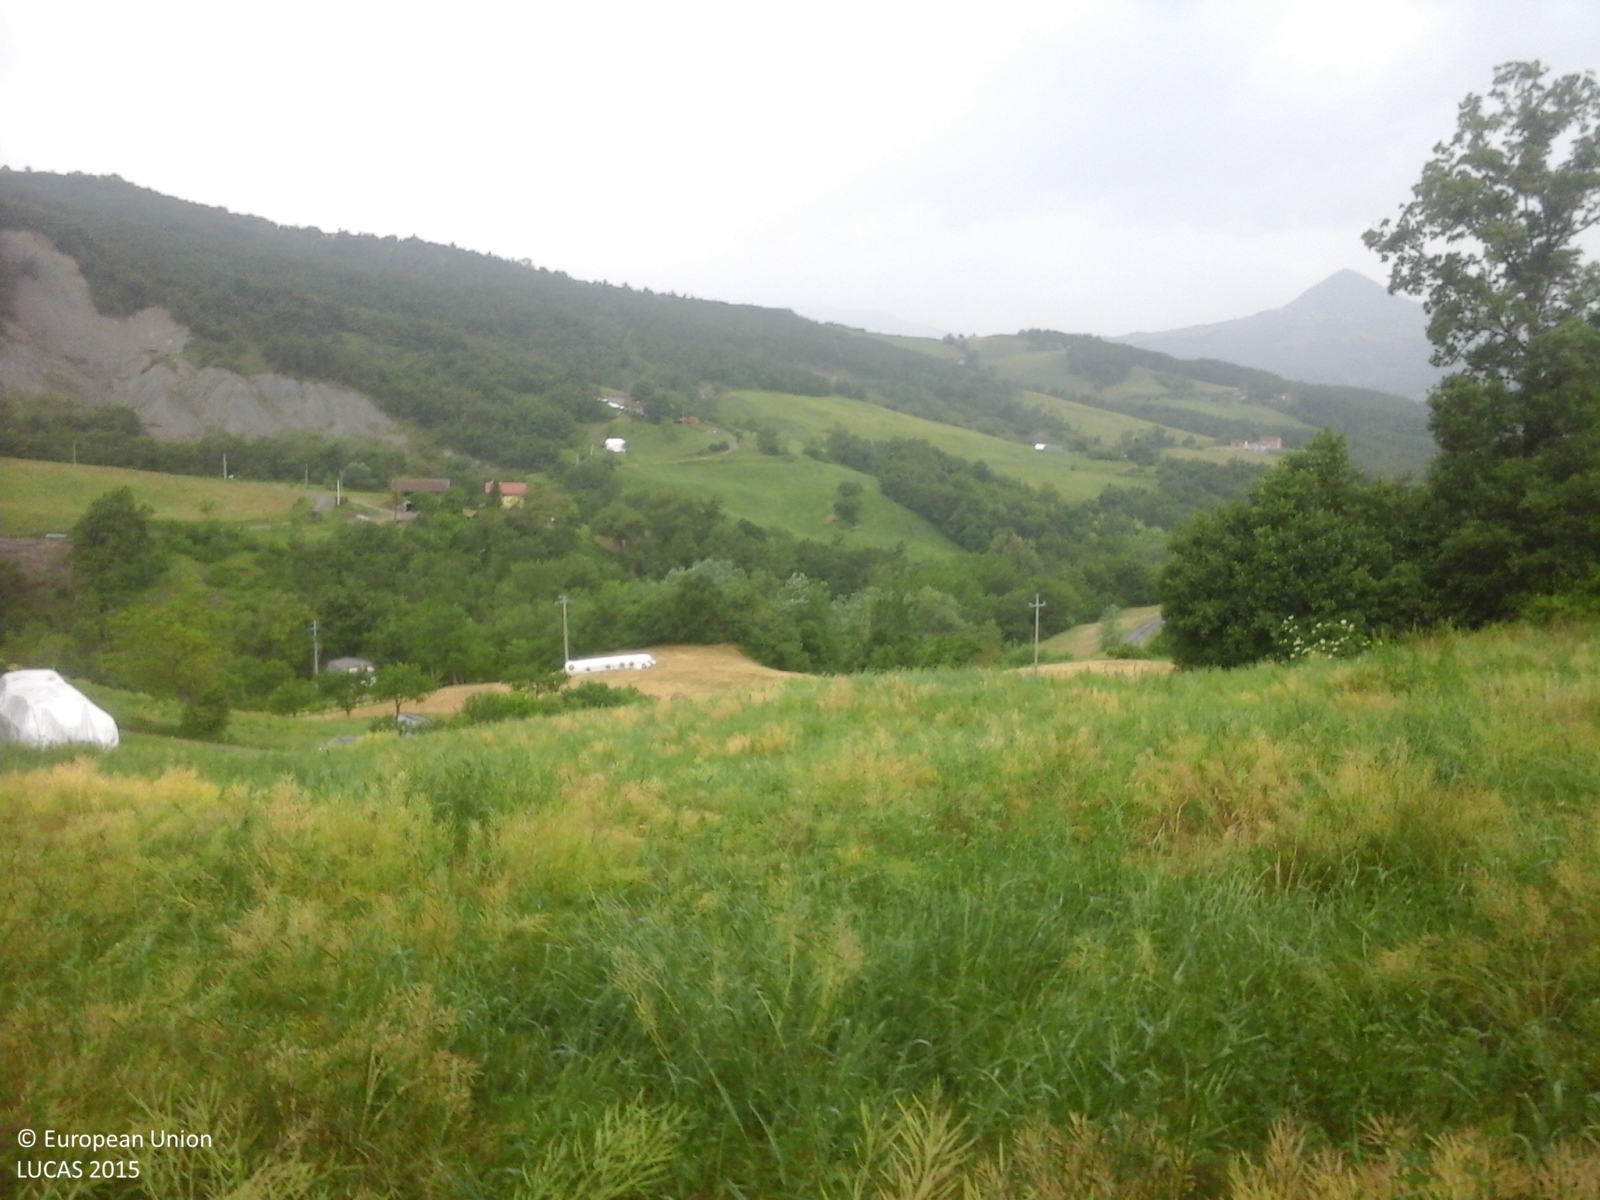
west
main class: Cropland
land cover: Lucerne
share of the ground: > 75 %
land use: Agriculture (excluding fallow land and kitchen gardens)
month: May
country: IT
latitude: 44.2744
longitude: 10.9125
